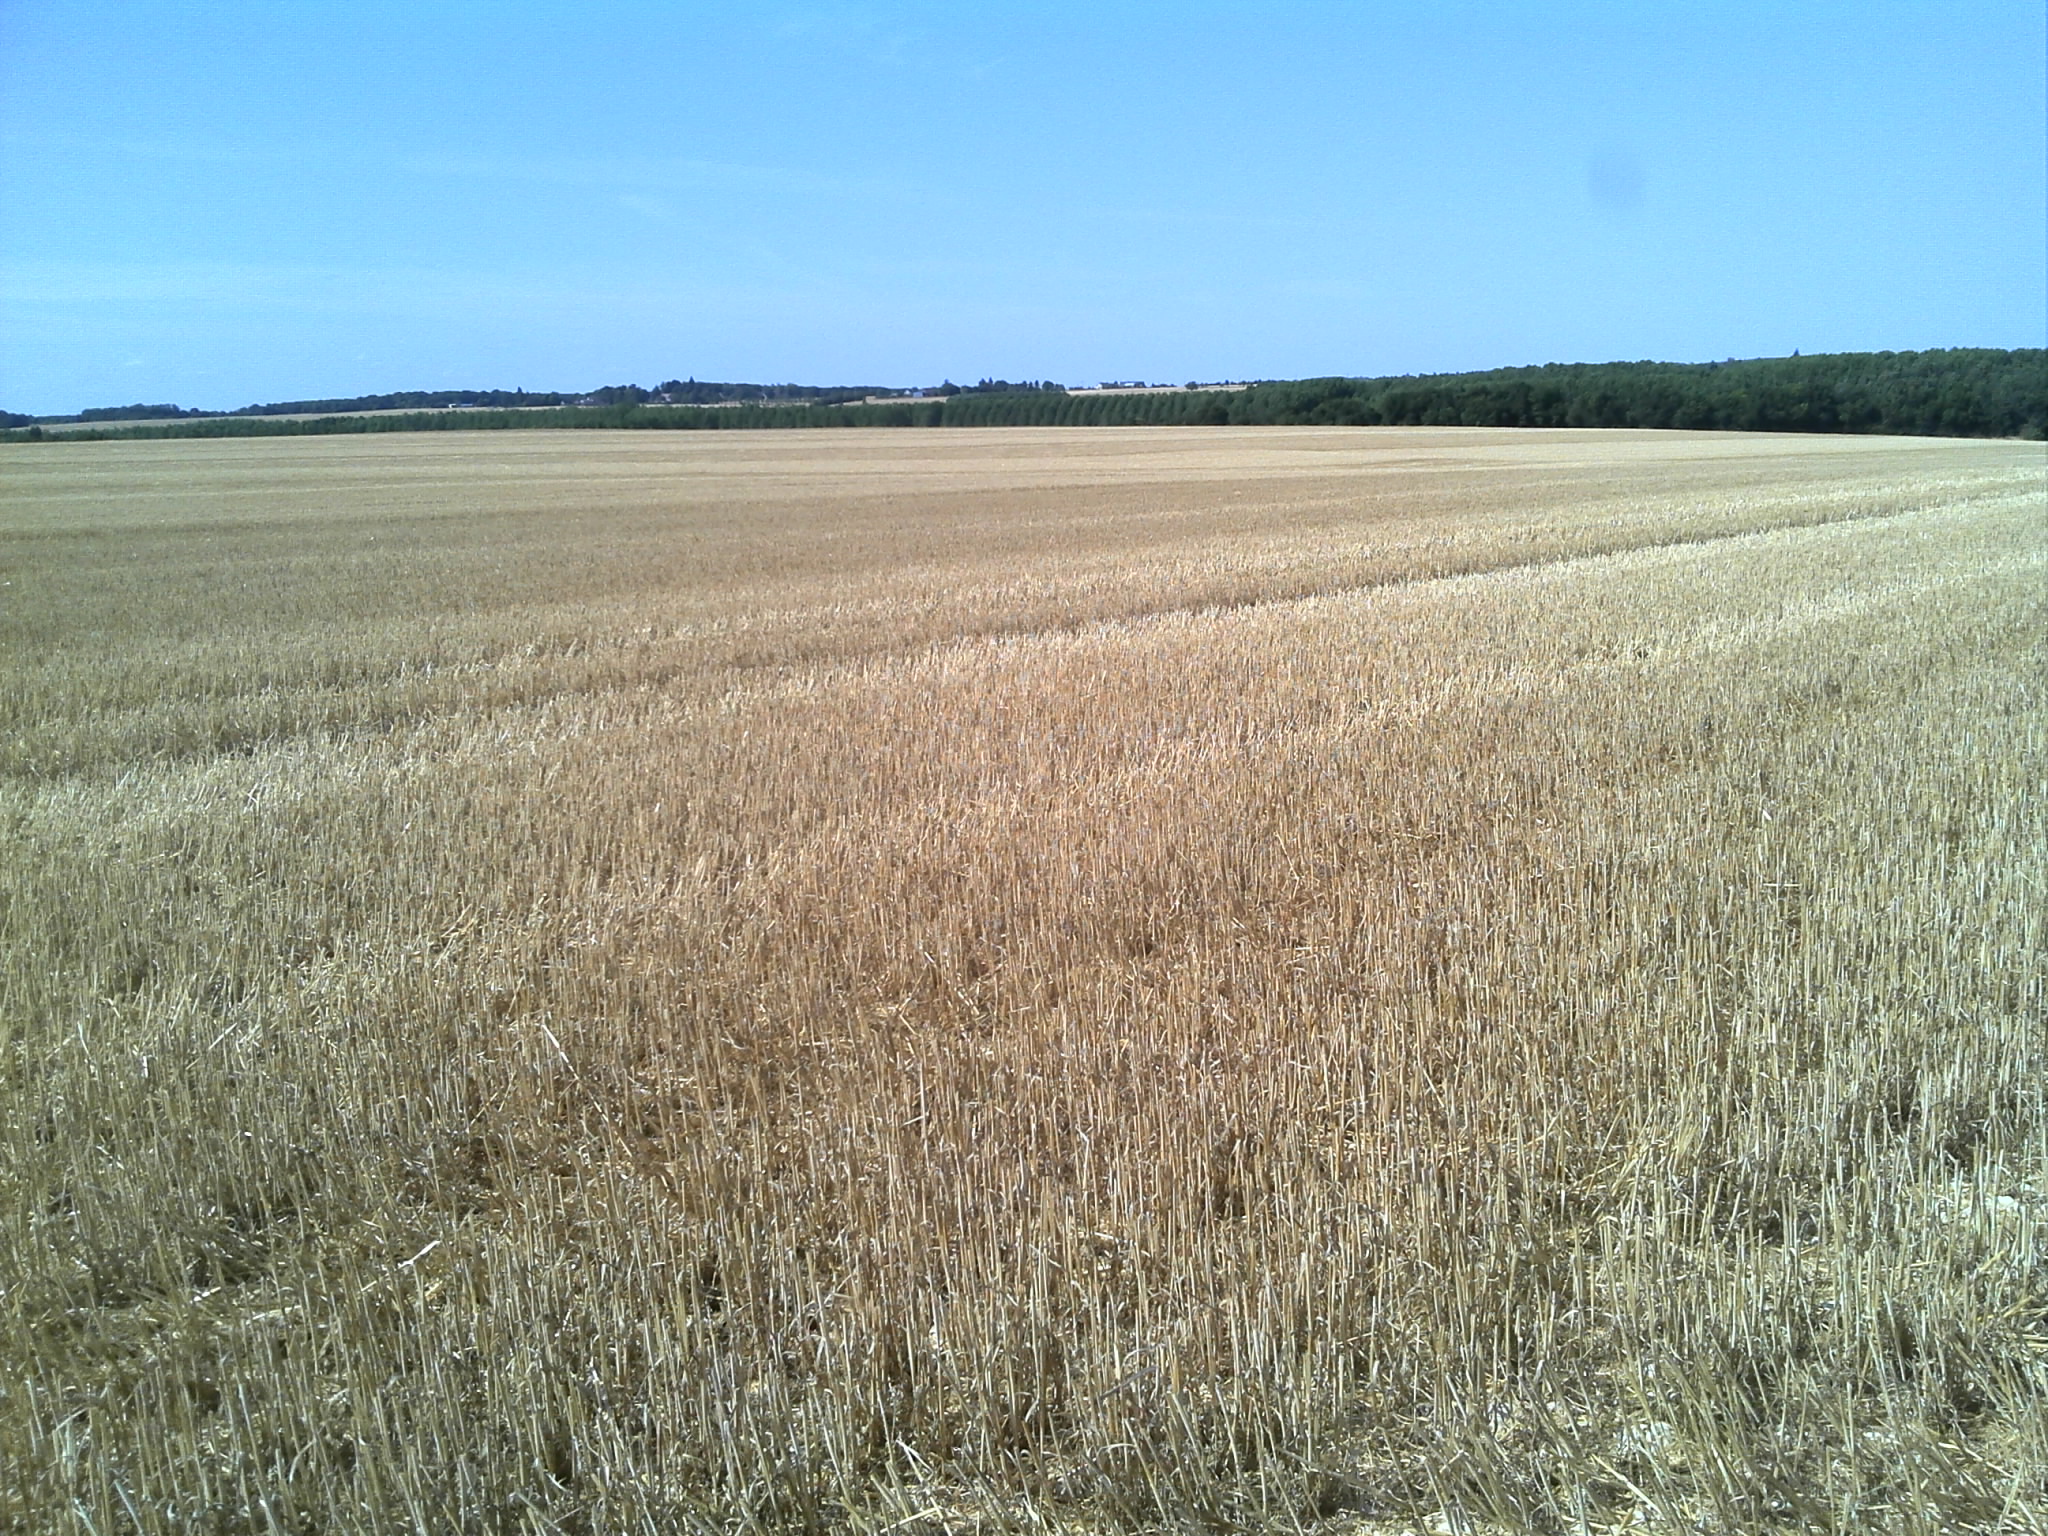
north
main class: Cropland
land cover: Durum wheat
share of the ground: > 75 %
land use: Agriculture (excluding fallow land and kitchen gardens)
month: July
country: FR
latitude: 46.8434
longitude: 1.4780
